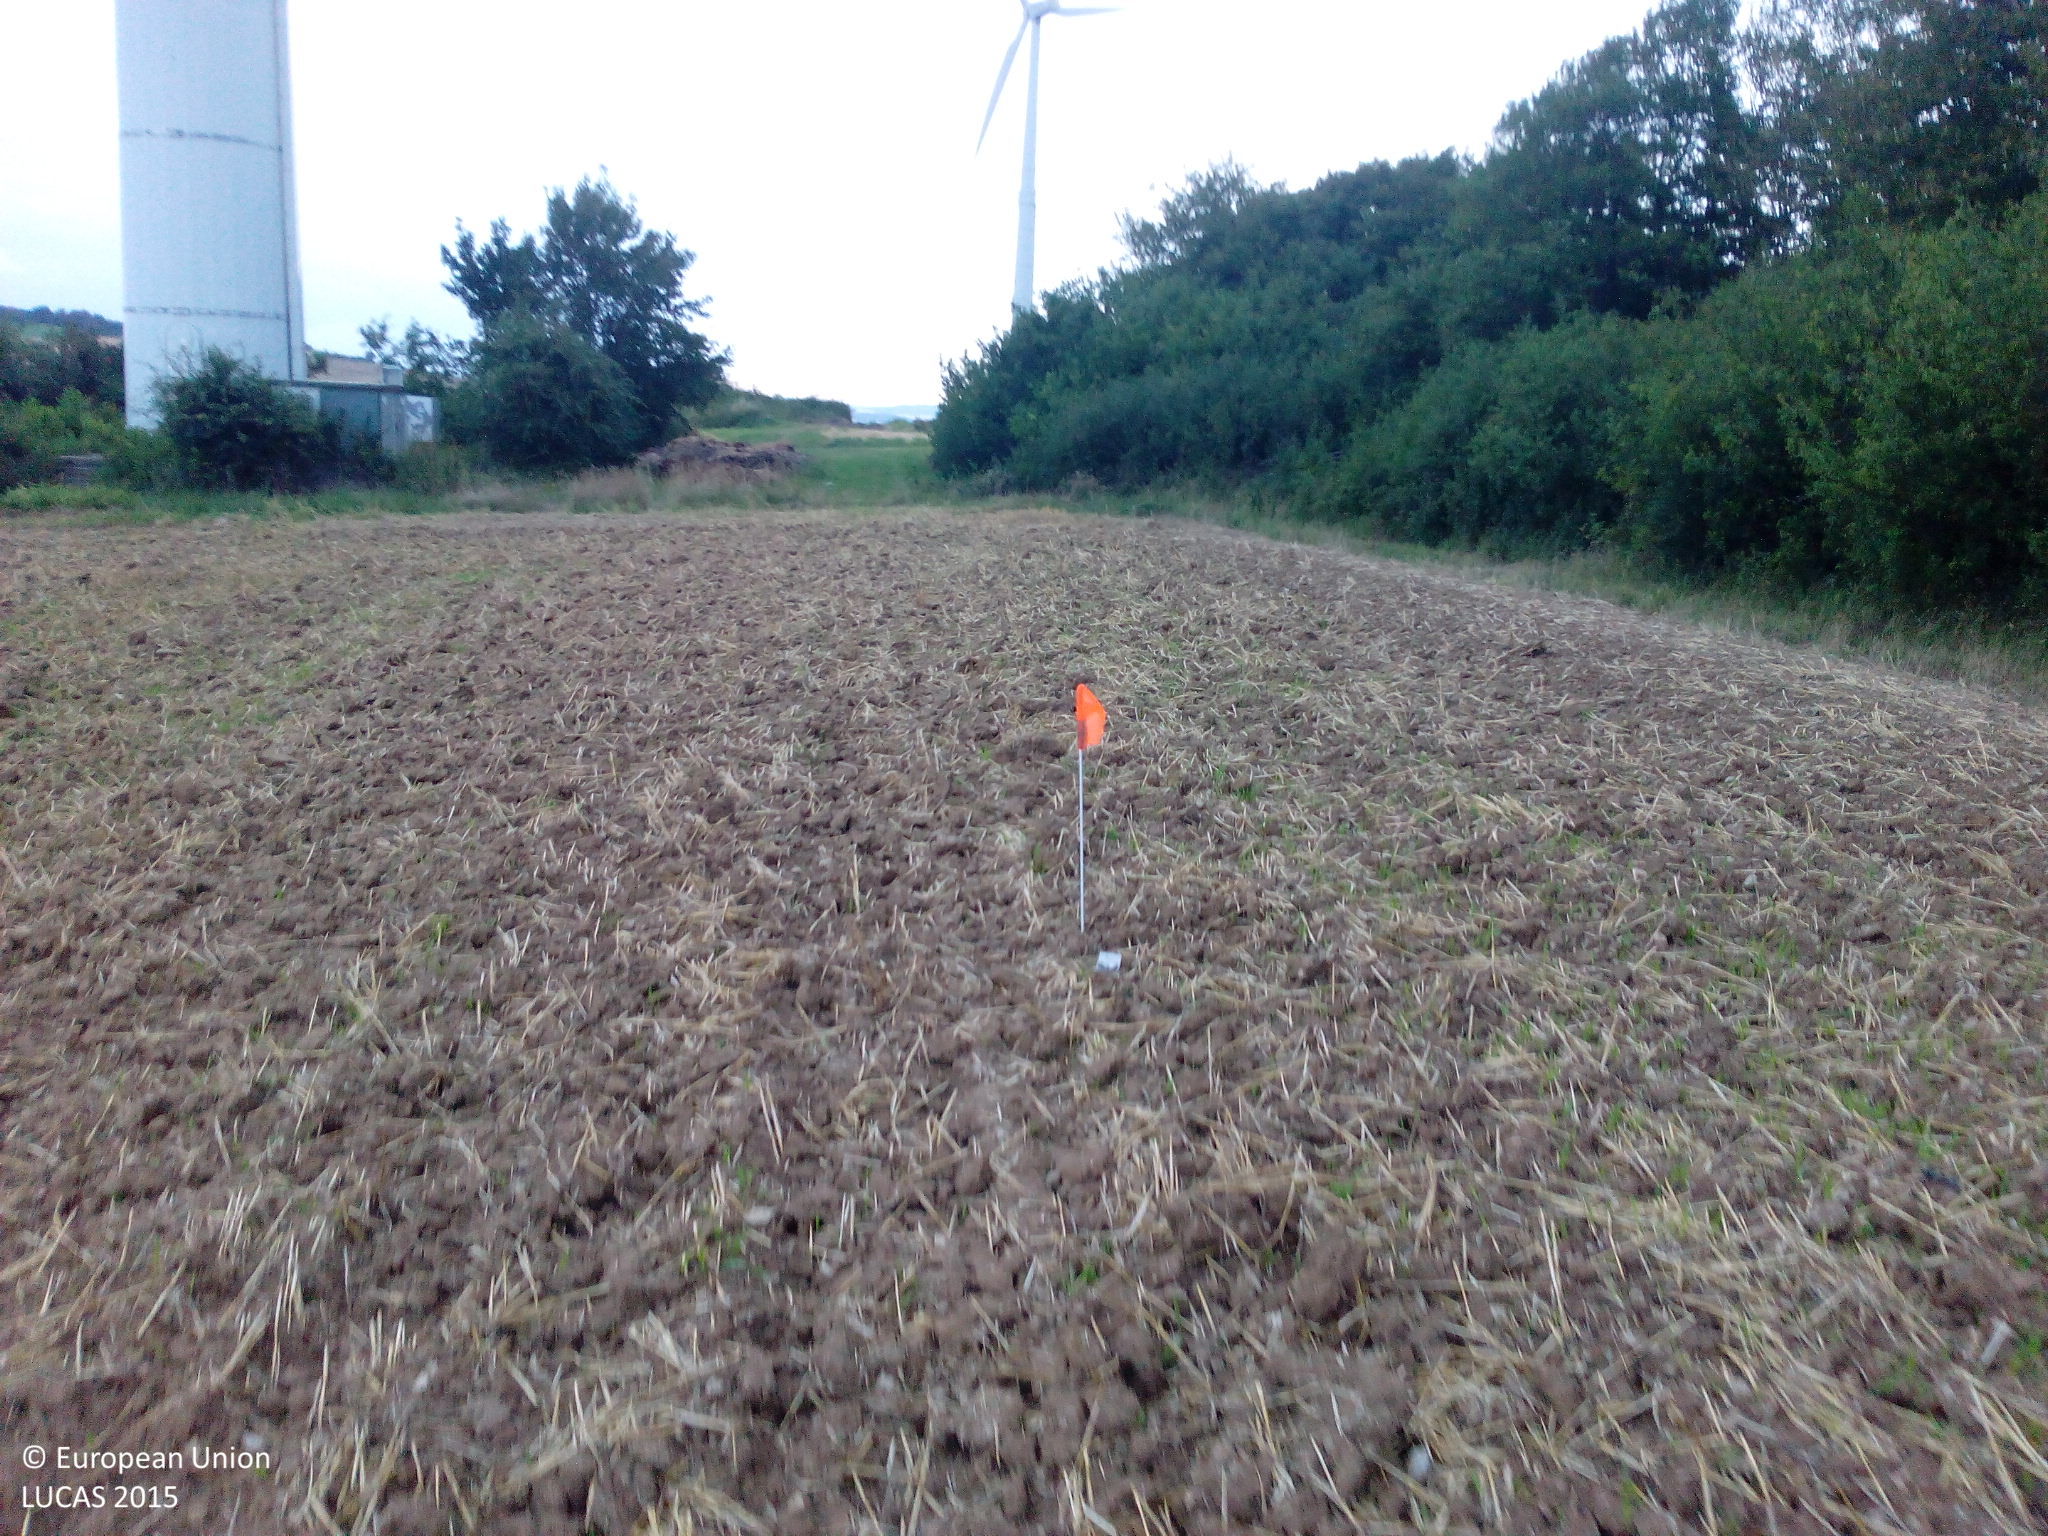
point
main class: Cropland
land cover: Rye
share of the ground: < 10 %
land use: Agriculture (excluding fallow land and kitchen gardens)
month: July
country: DE
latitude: 51.4582
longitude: 9.2374
